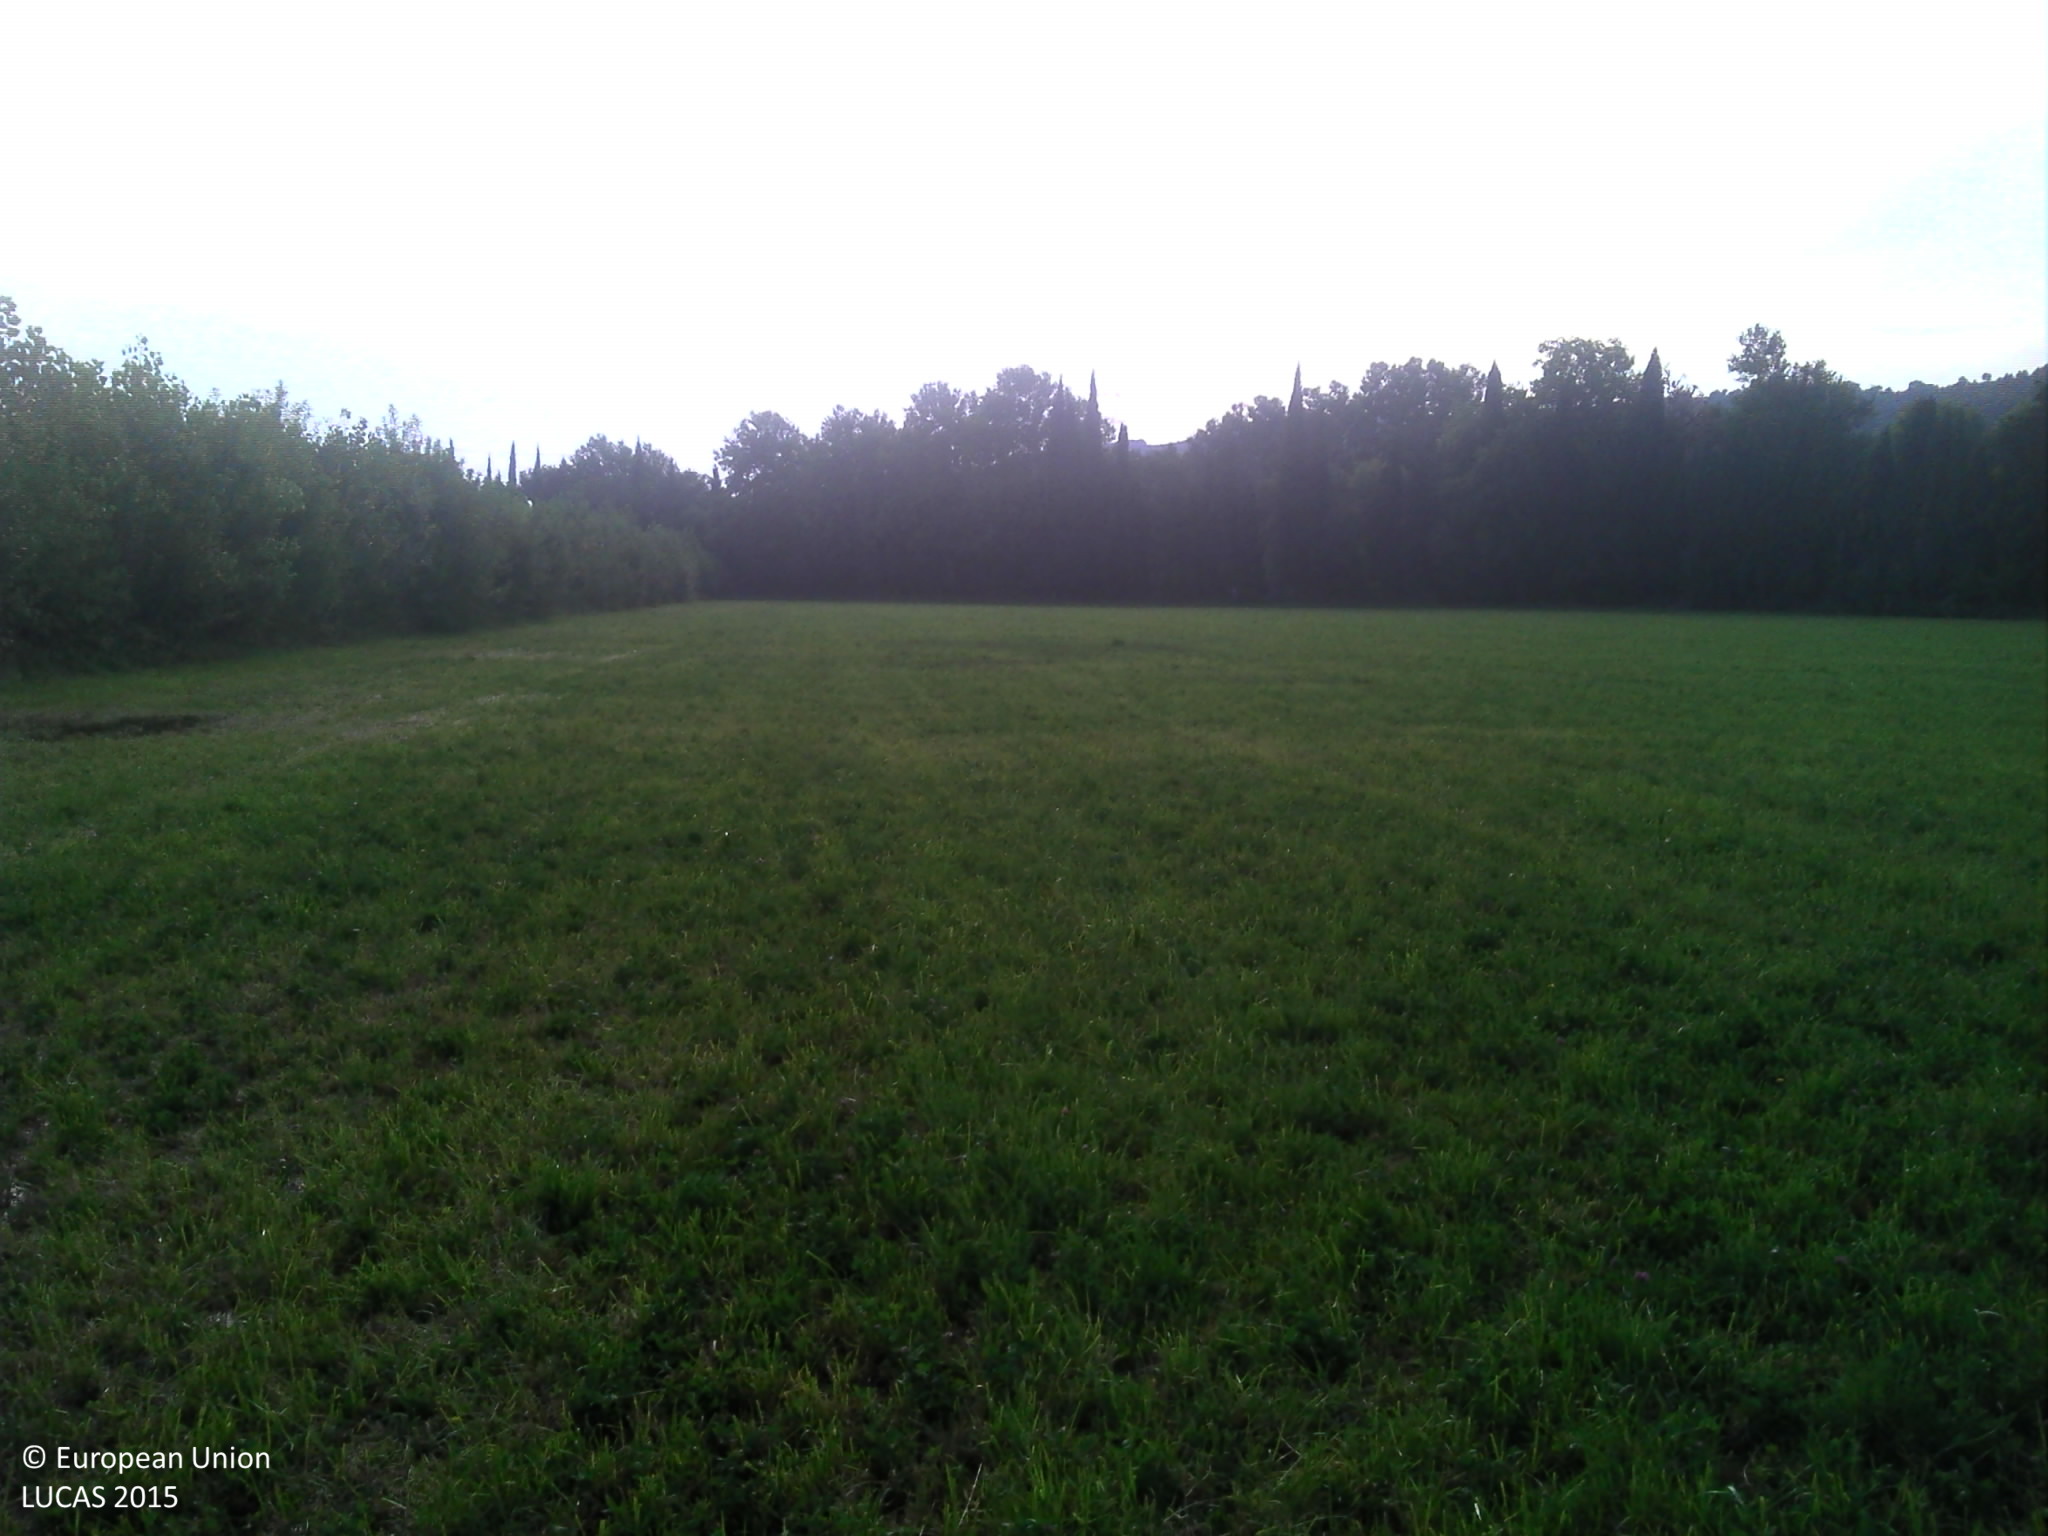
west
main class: Grassland
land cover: Grassland without tree/shrub cover
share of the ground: > 75 %
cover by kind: herbaceous plants 95 %, shrubs 5 %
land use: Agriculture (excluding fallow land and kitchen gardens)
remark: Temporary flooded
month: July
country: FR
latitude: 43.6919
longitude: 5.0838
